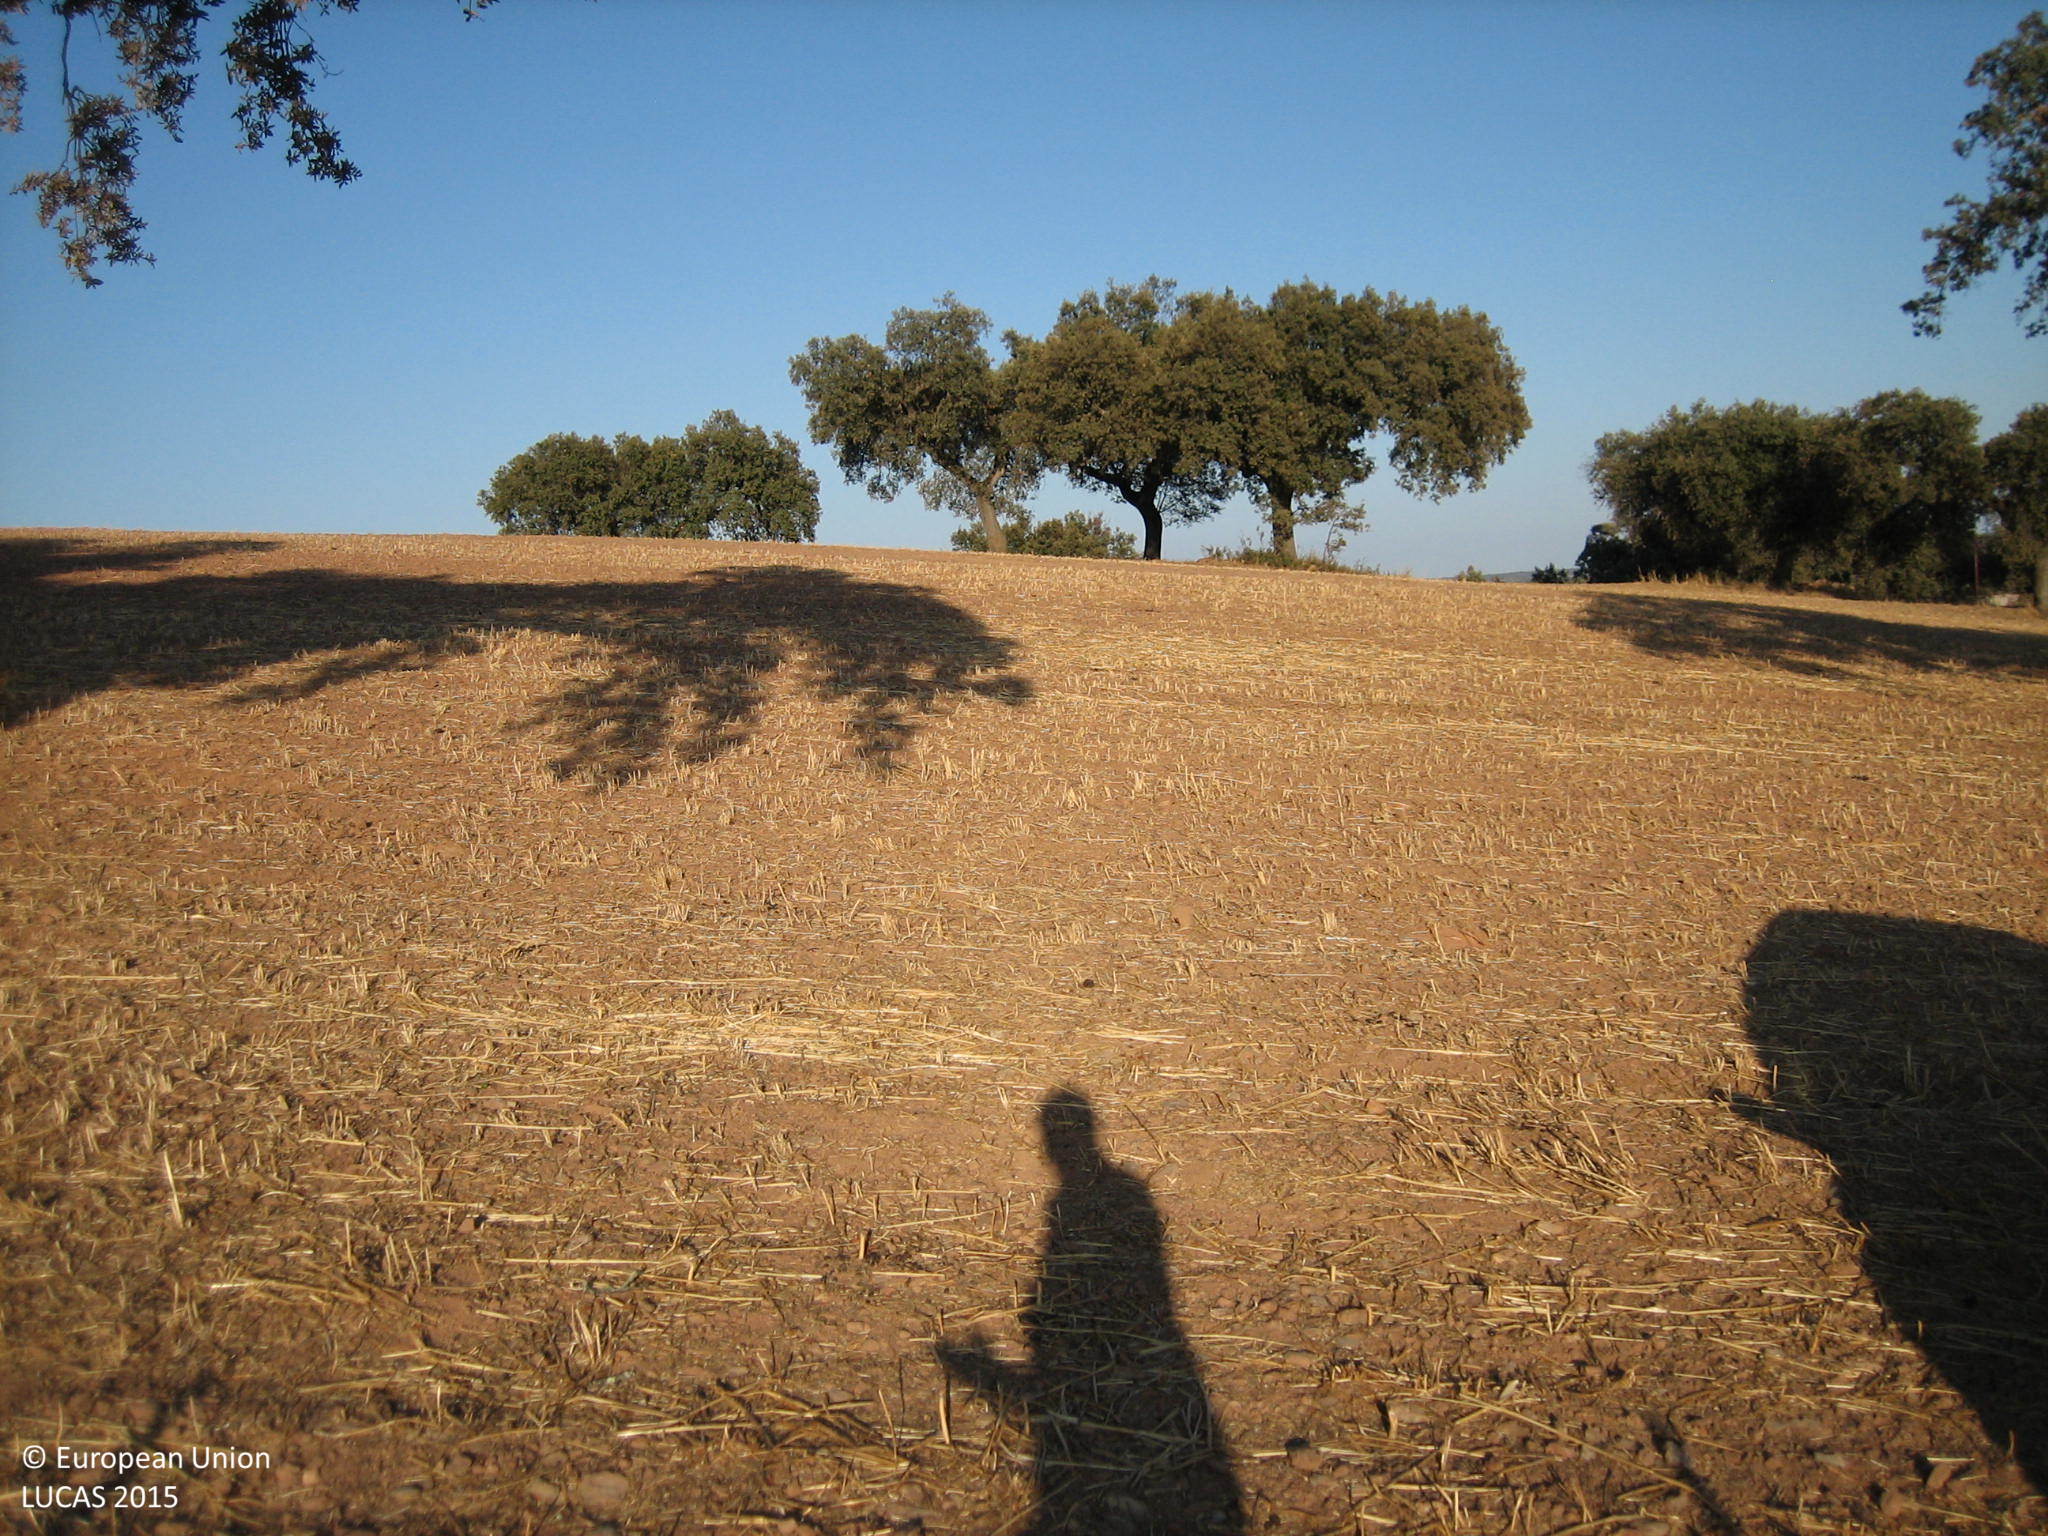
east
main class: Grassland
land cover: Grassland without tree/shrub cover
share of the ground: 50 - 75 %
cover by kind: herbaceous plants 70 %, unconsolidated bare surface 30 %
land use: Agriculture (excluding fallow land and kitchen gardens)
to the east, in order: Grassland without tree/shrub cover; Dry stone walls; Fences; Broadleaved woodland; Fences; Tracks; Dry stone walls; Broadleaved woodland; Tracks; Olive groves; Dry stone walls; Grassland without tree/shrub cover
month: September
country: ES
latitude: 38.3746
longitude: -7.1540
